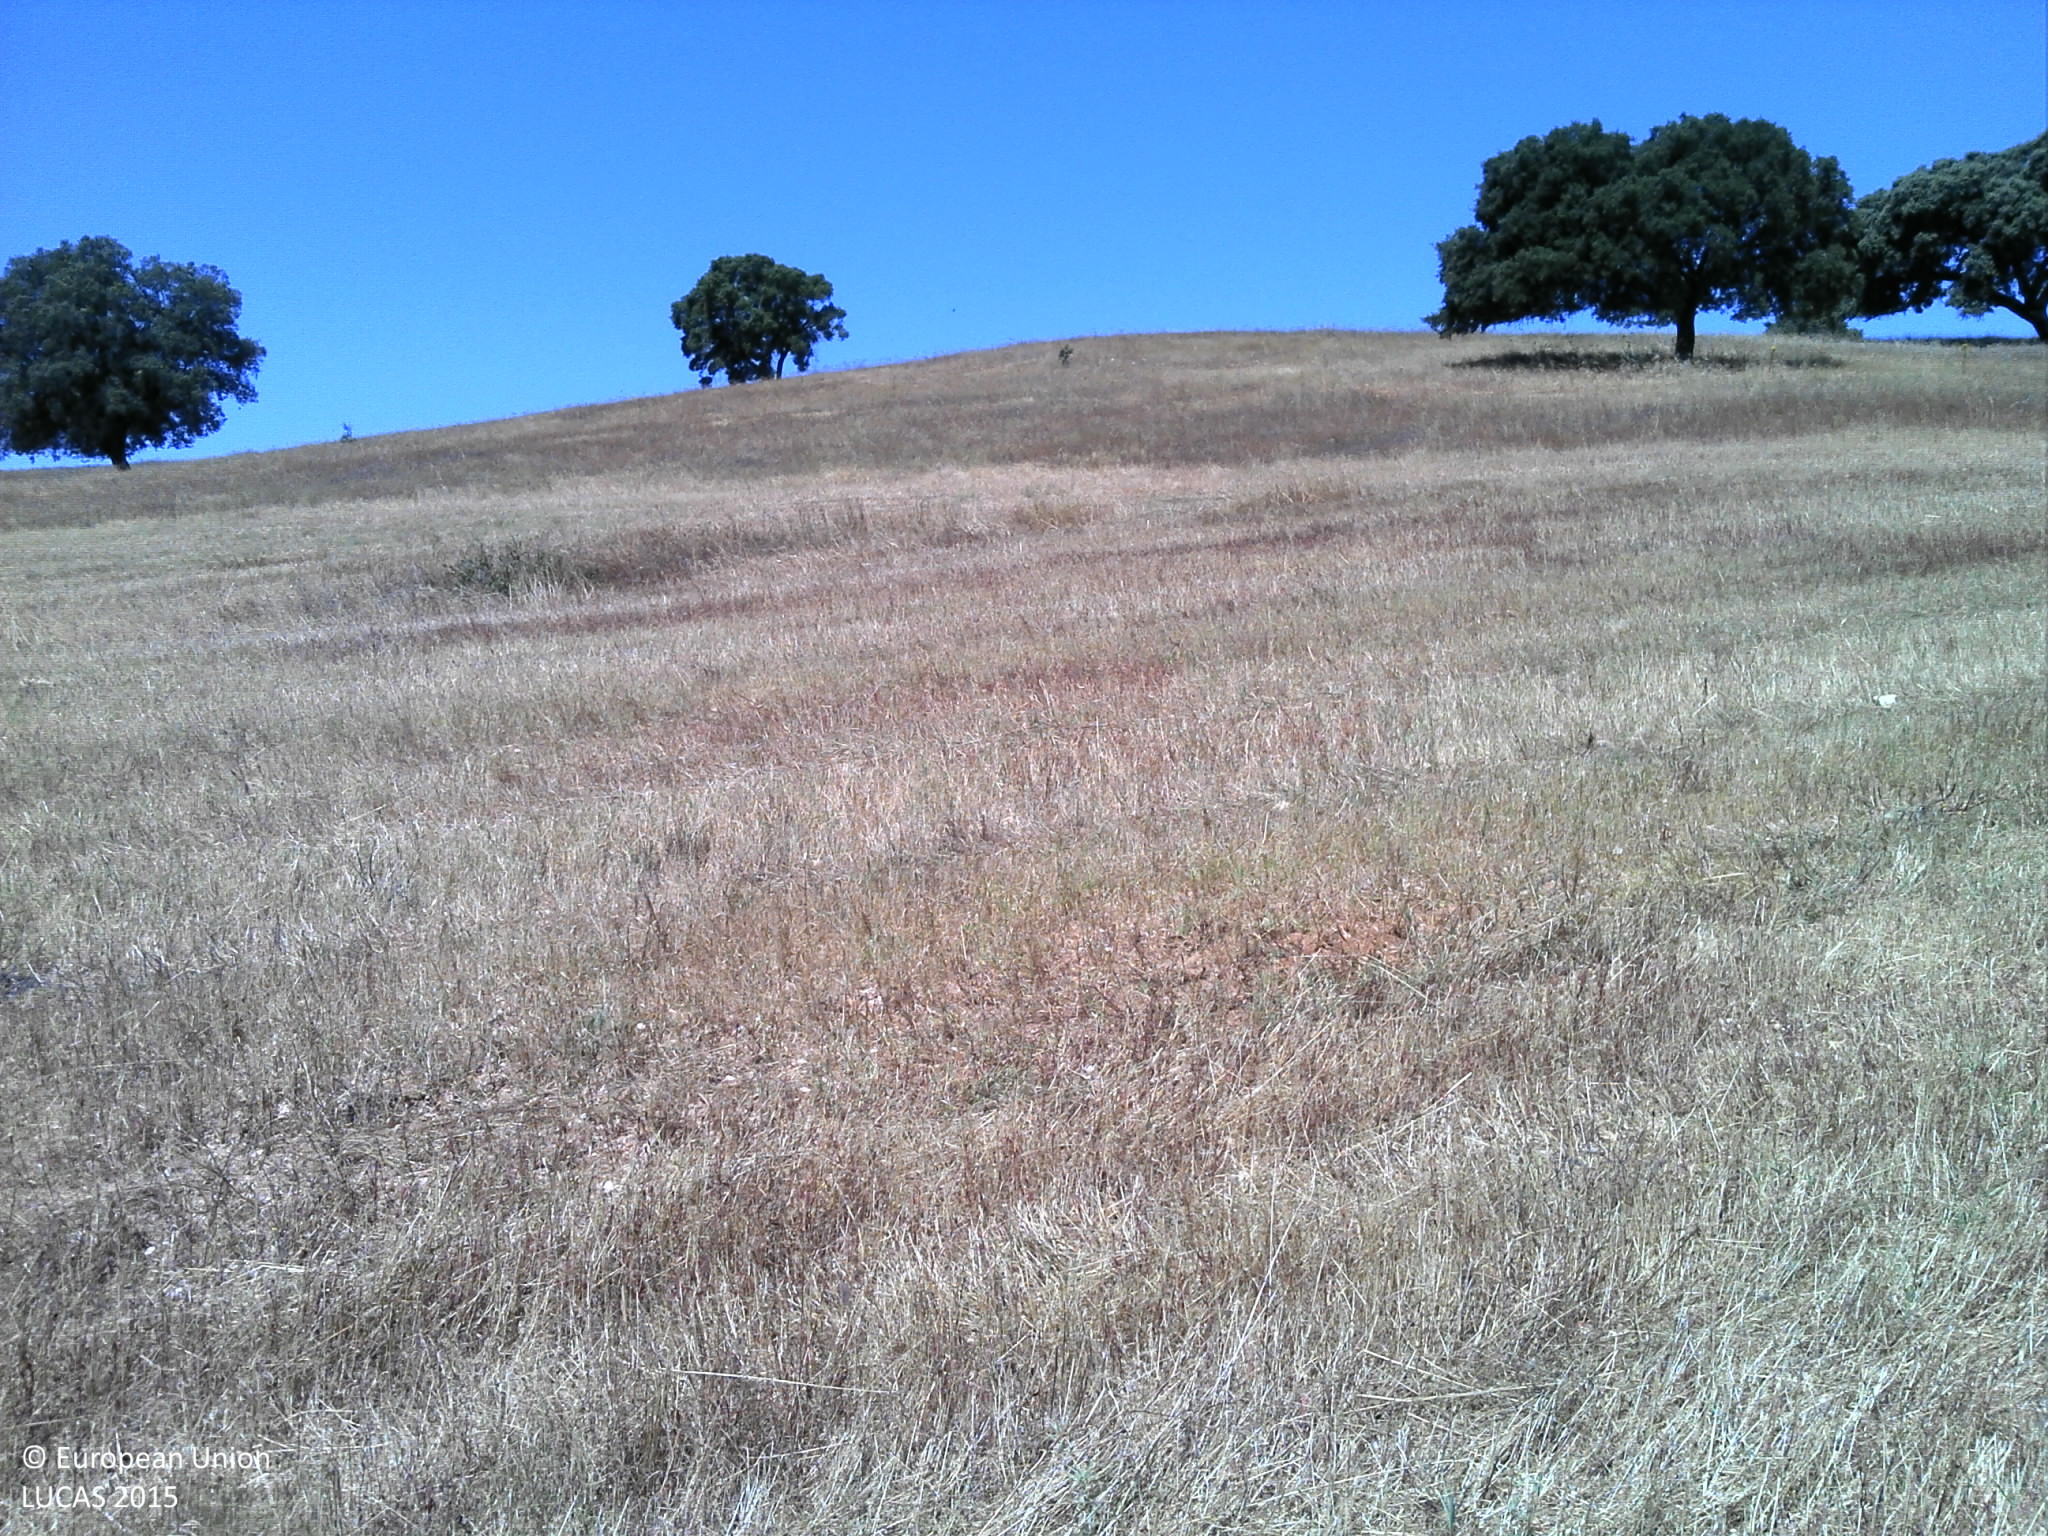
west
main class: Grassland
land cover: Spontaneously vegetated surfaces
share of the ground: 50 - 75 %
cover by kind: herbaceous plants 50 %, consolidated bare surface 50 %
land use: Agriculture (excluding fallow land and kitchen gardens)
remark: Harvested field
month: July
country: PT
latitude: 37.7532
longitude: -8.2948
